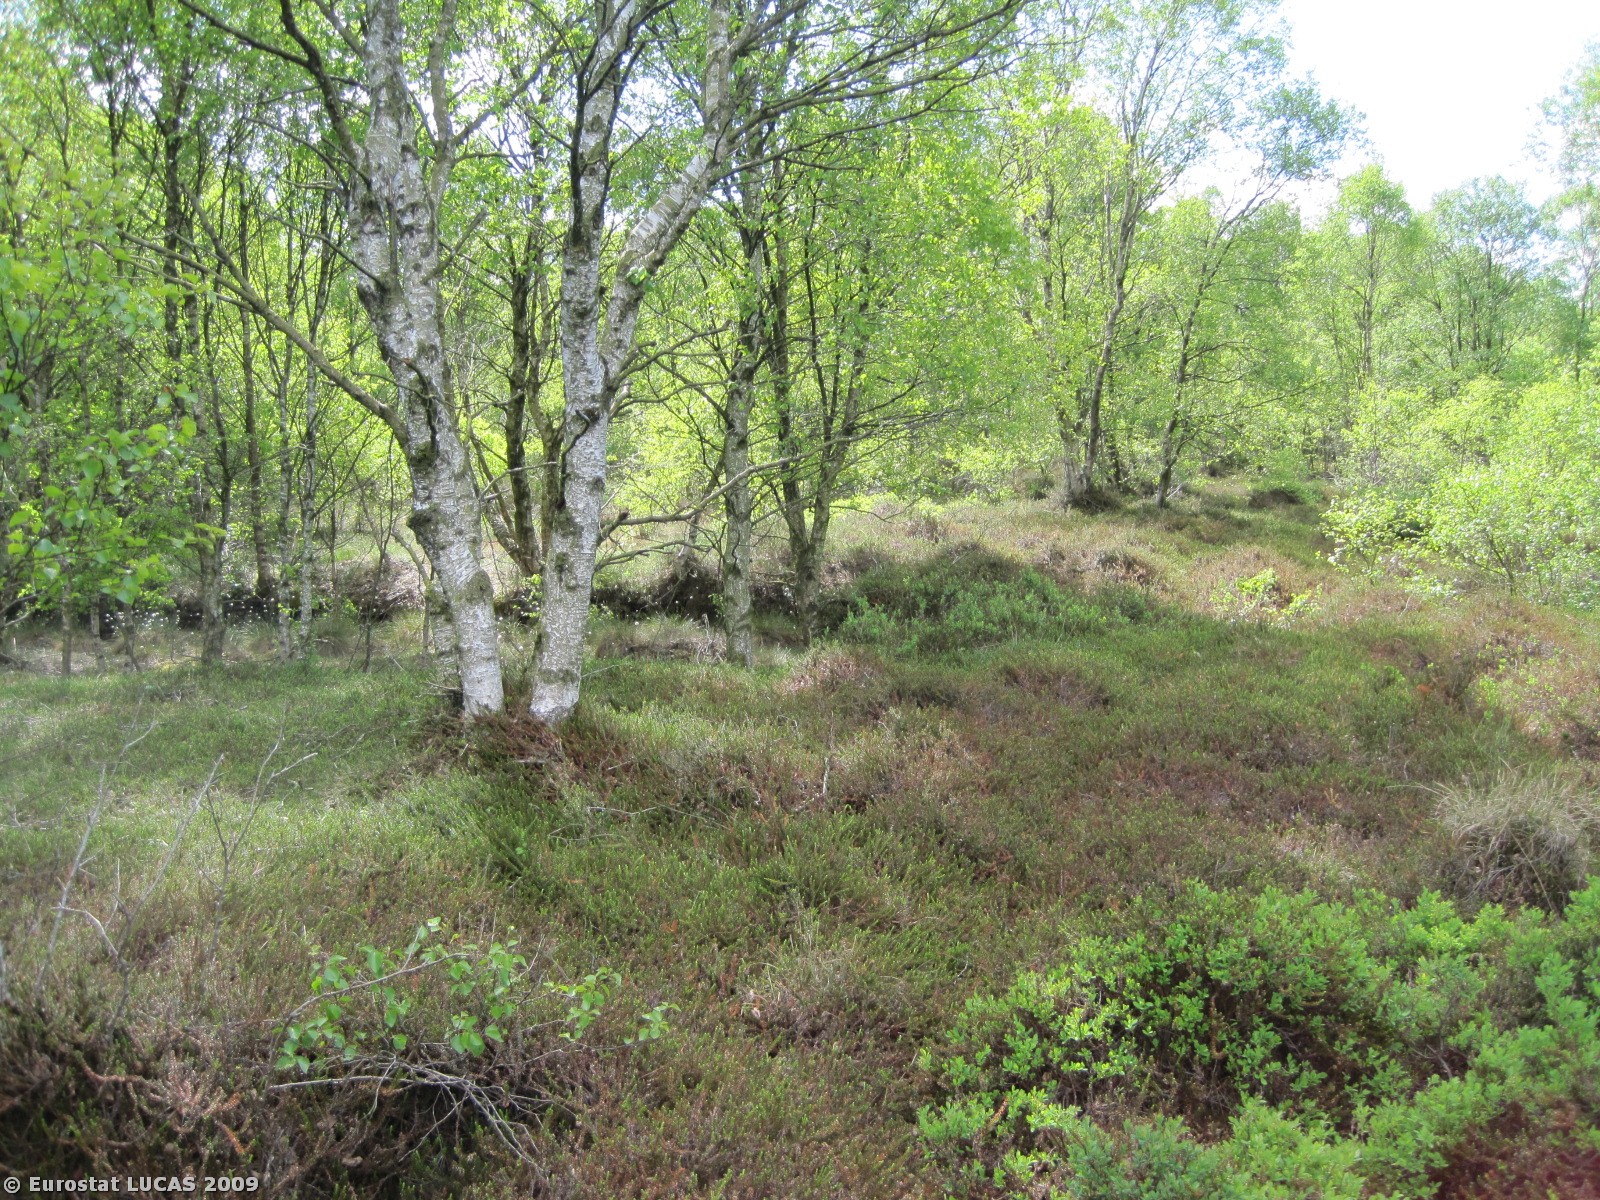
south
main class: Shrubland
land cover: Shrubland with sparse tree cover
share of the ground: > 75 %
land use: Unused
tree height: > 5 m
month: May
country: DK
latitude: 56.8887
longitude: 10.1803
